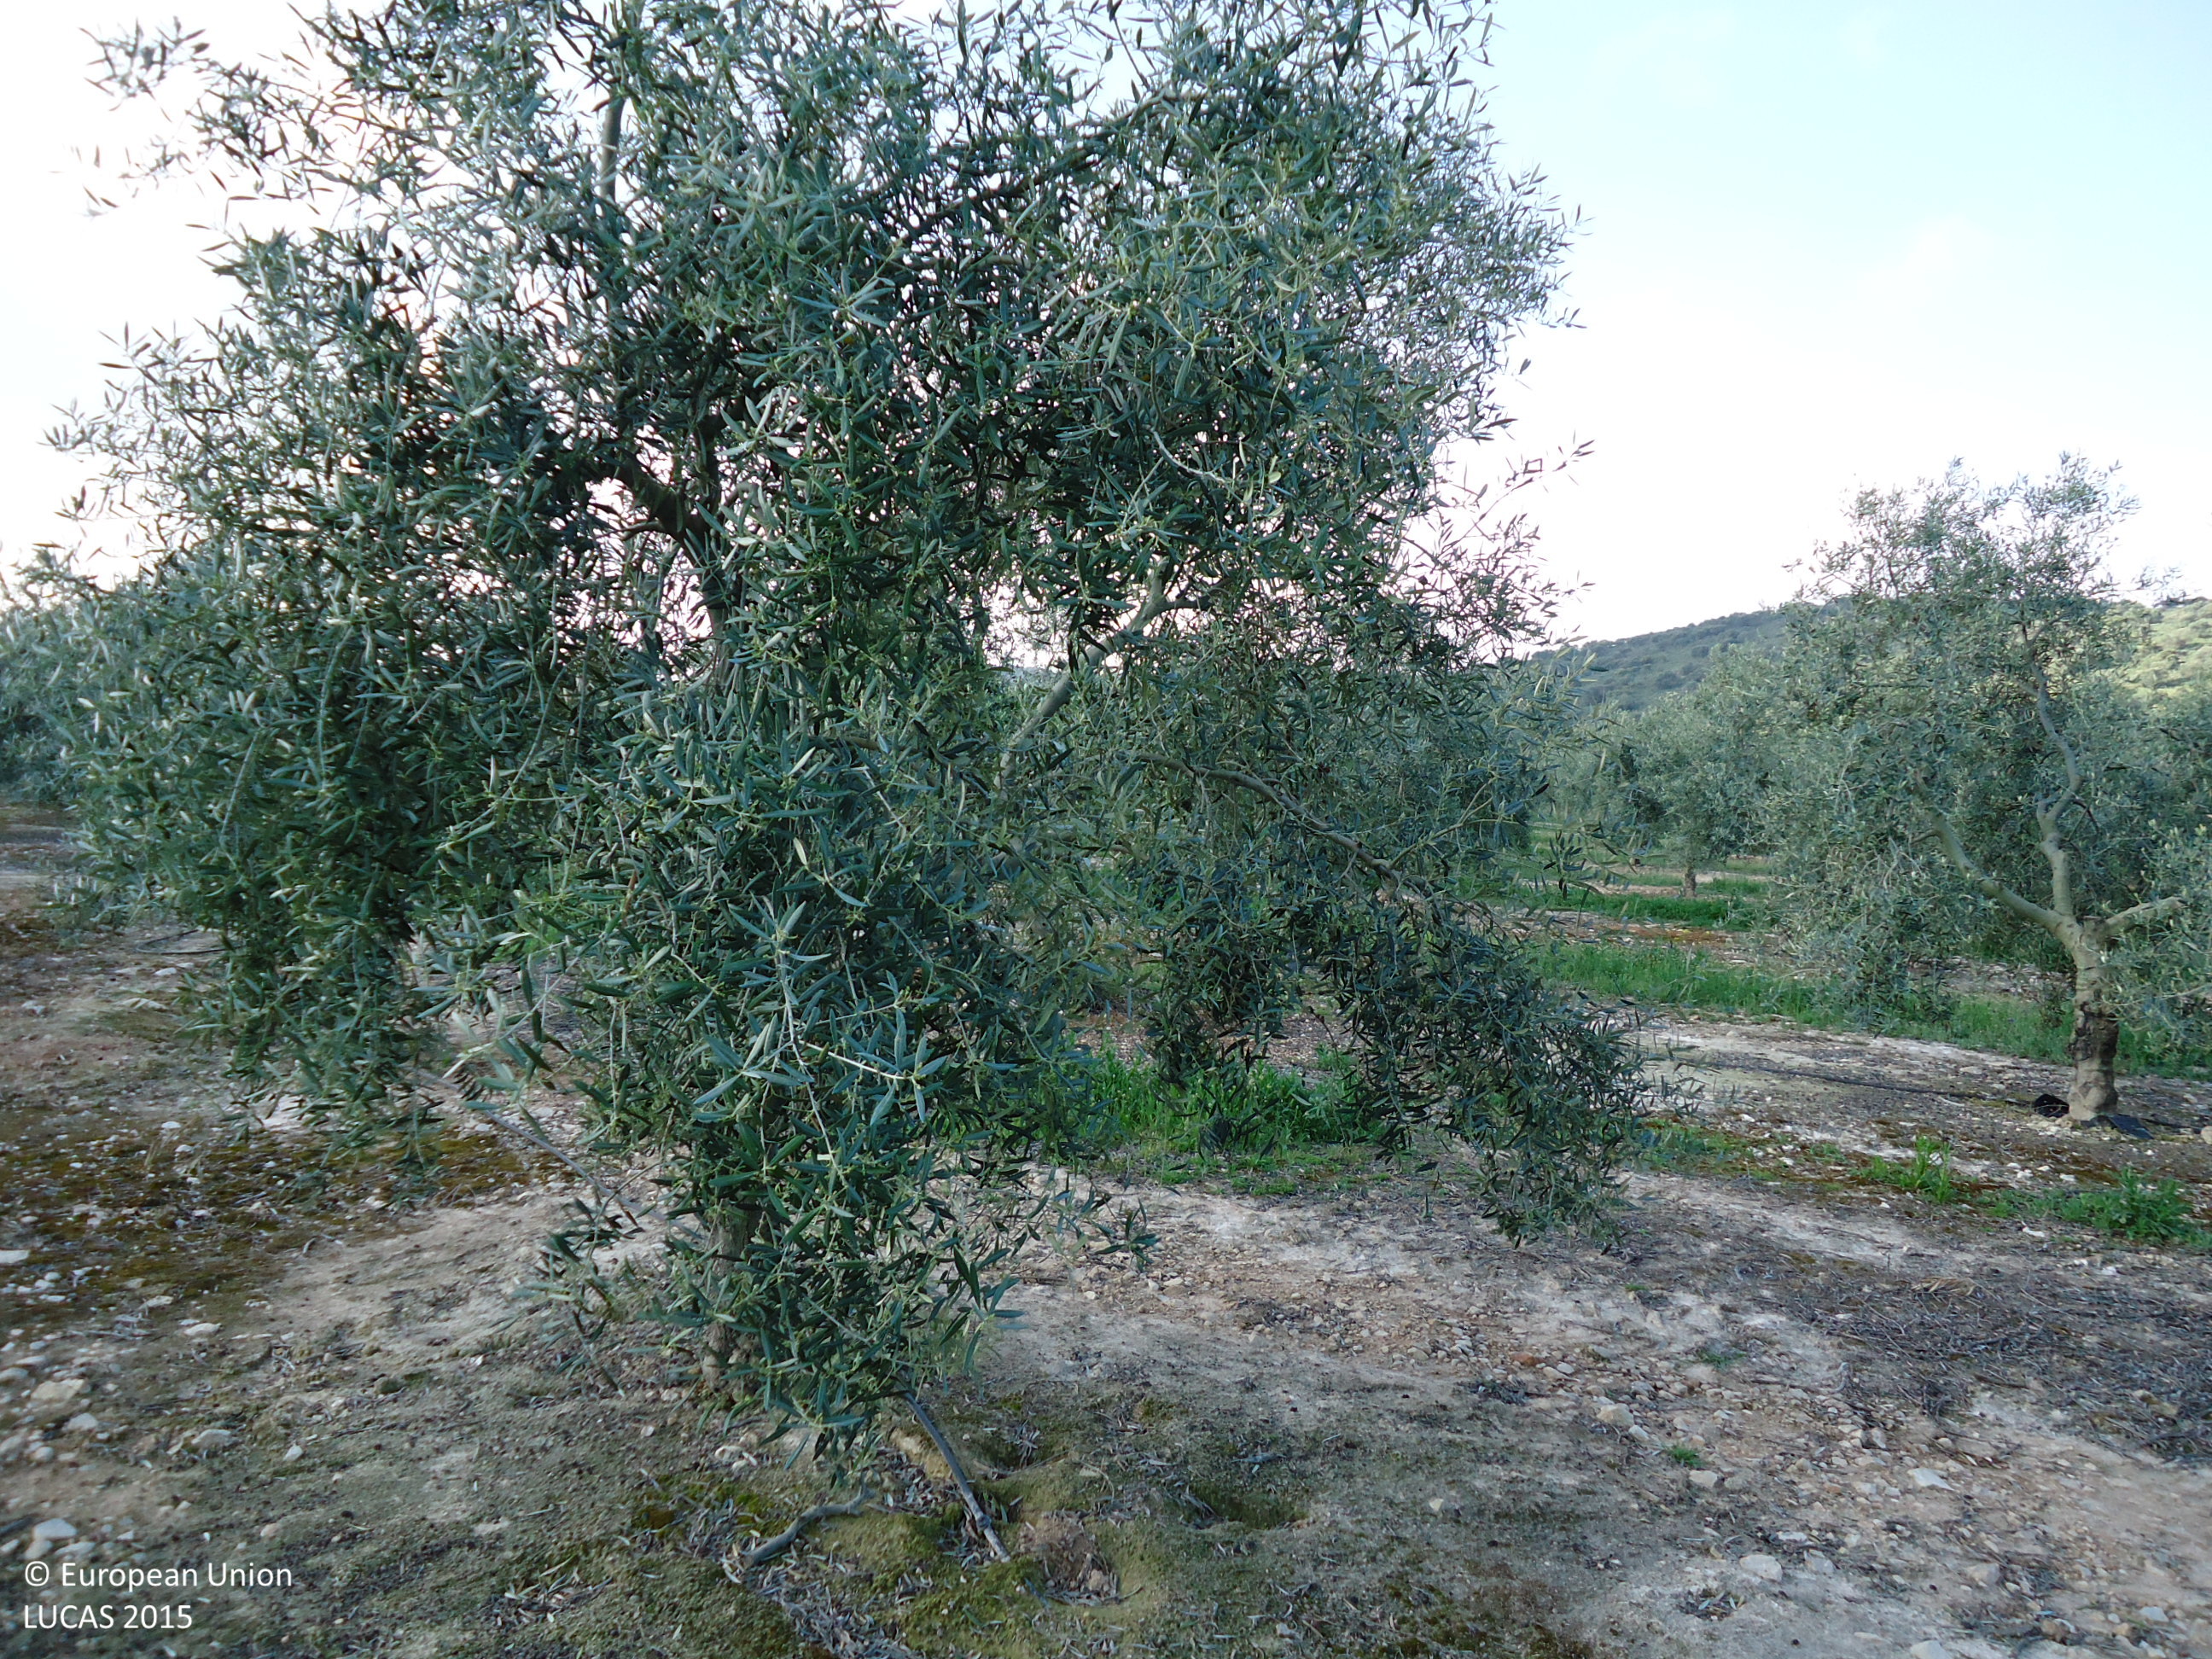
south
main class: Cropland
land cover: Olive groves
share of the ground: 25 - 50 %
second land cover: Spontaneously vegetated surfaces
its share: 50 - 75 %
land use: Agriculture (excluding fallow land and kitchen gardens)
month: April
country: ES
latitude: 37.1802
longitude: -4.8600
